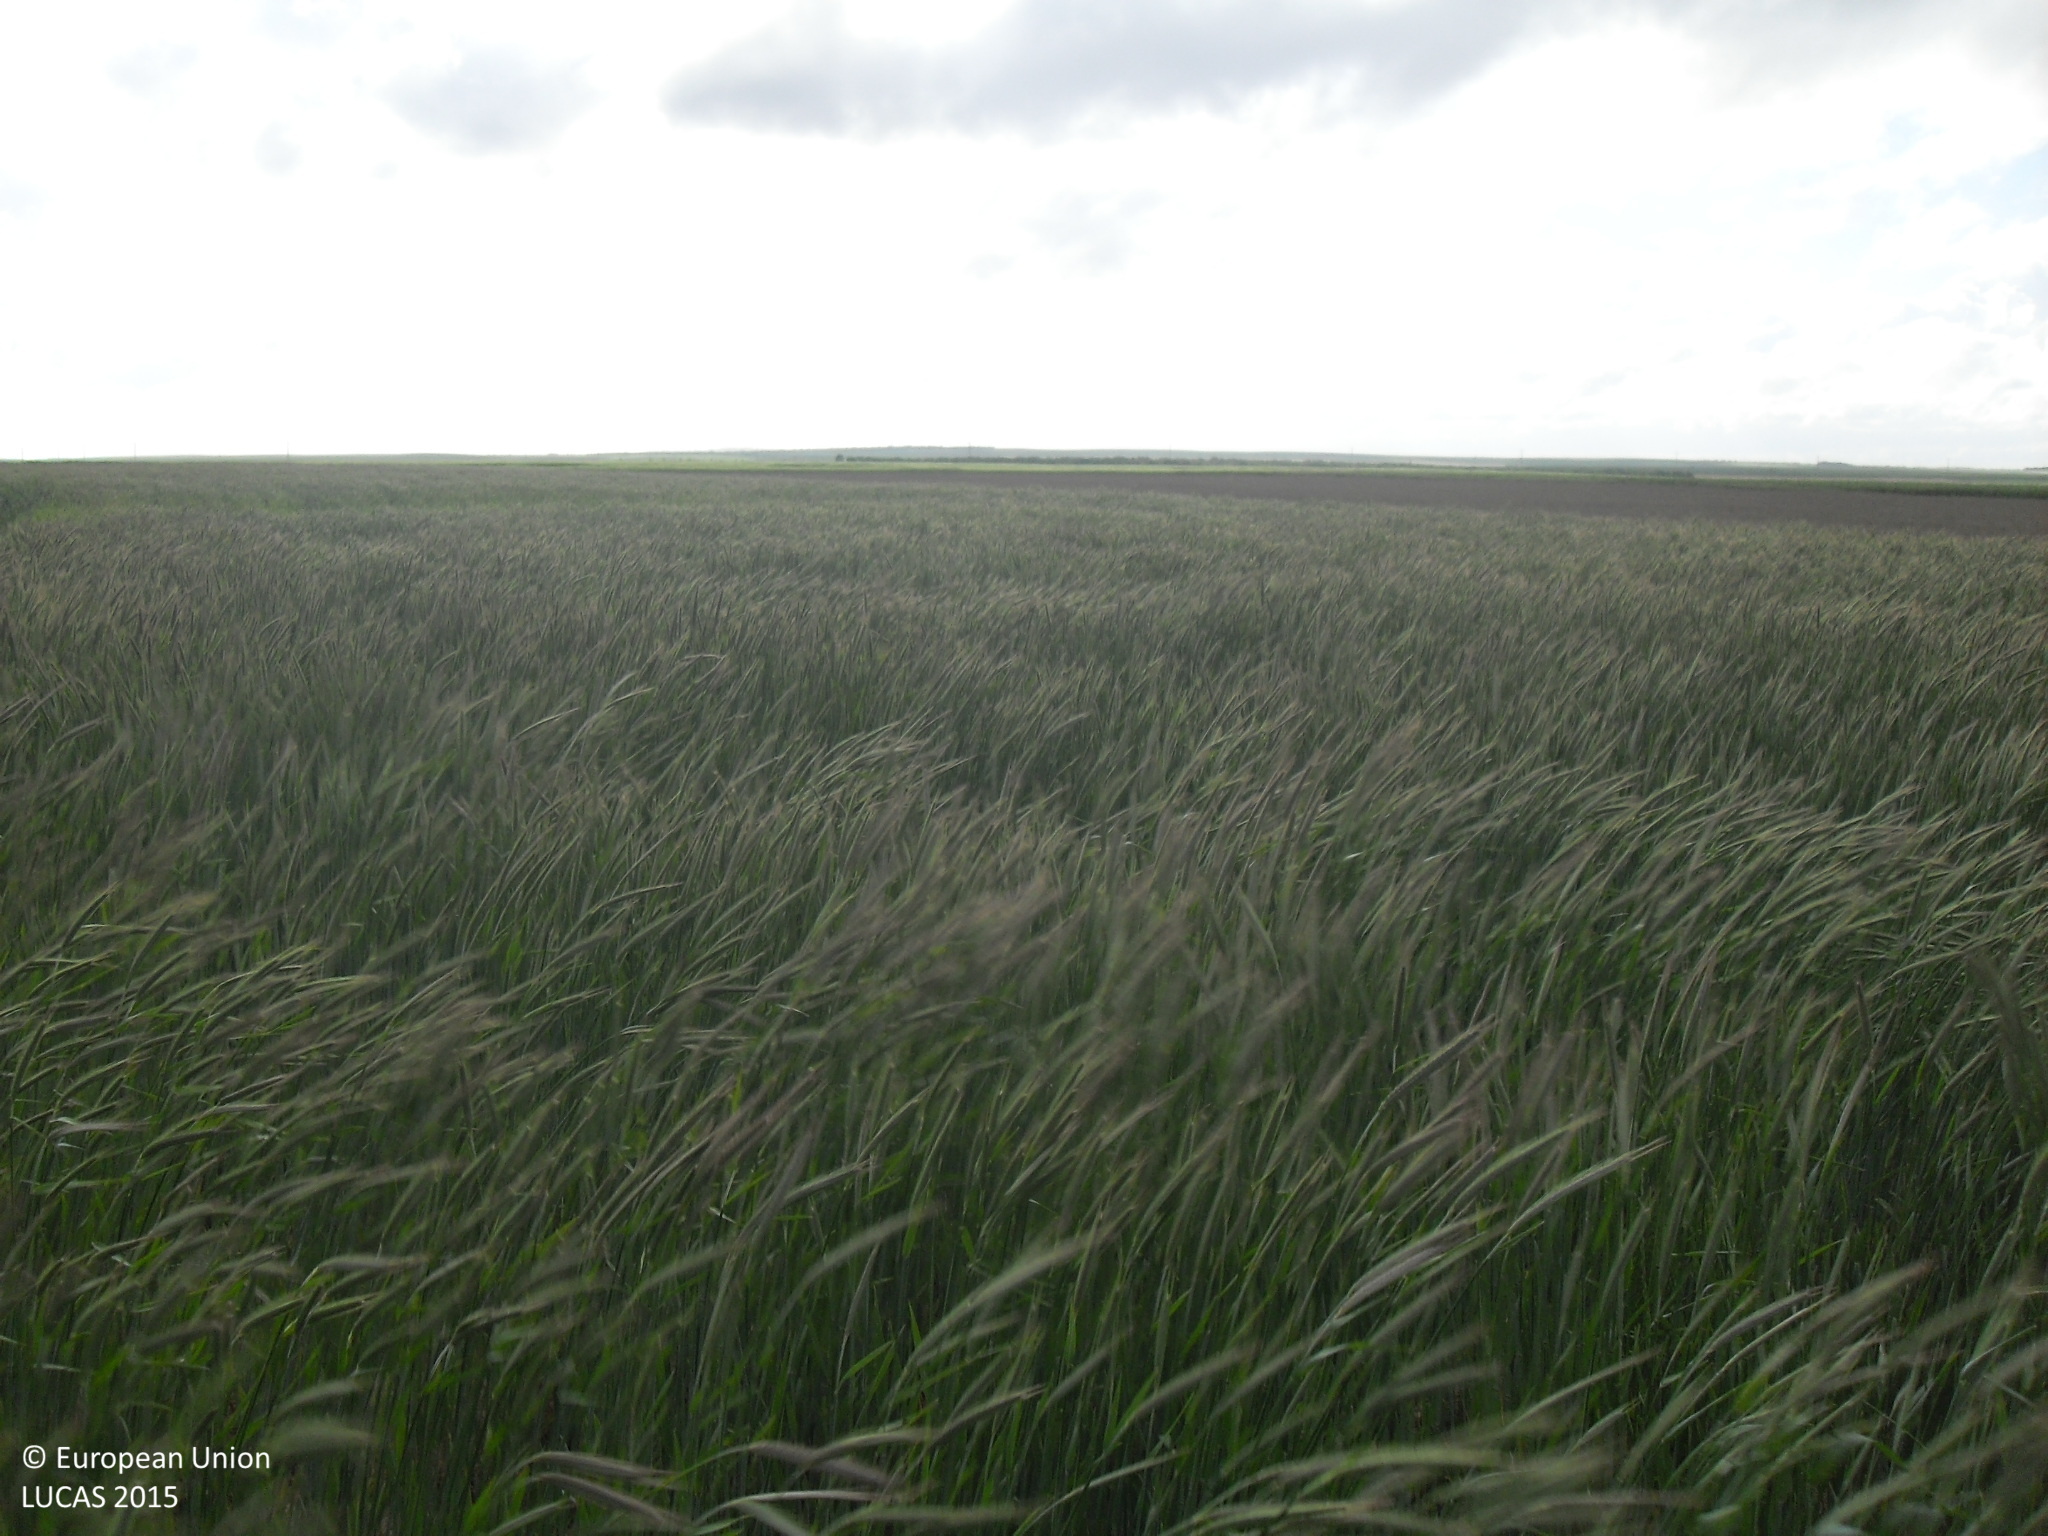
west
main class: Cropland
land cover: Rye
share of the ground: > 75 %
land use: Agriculture (excluding fallow land and kitchen gardens)
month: May
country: ES
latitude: 40.9922
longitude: -5.2738
